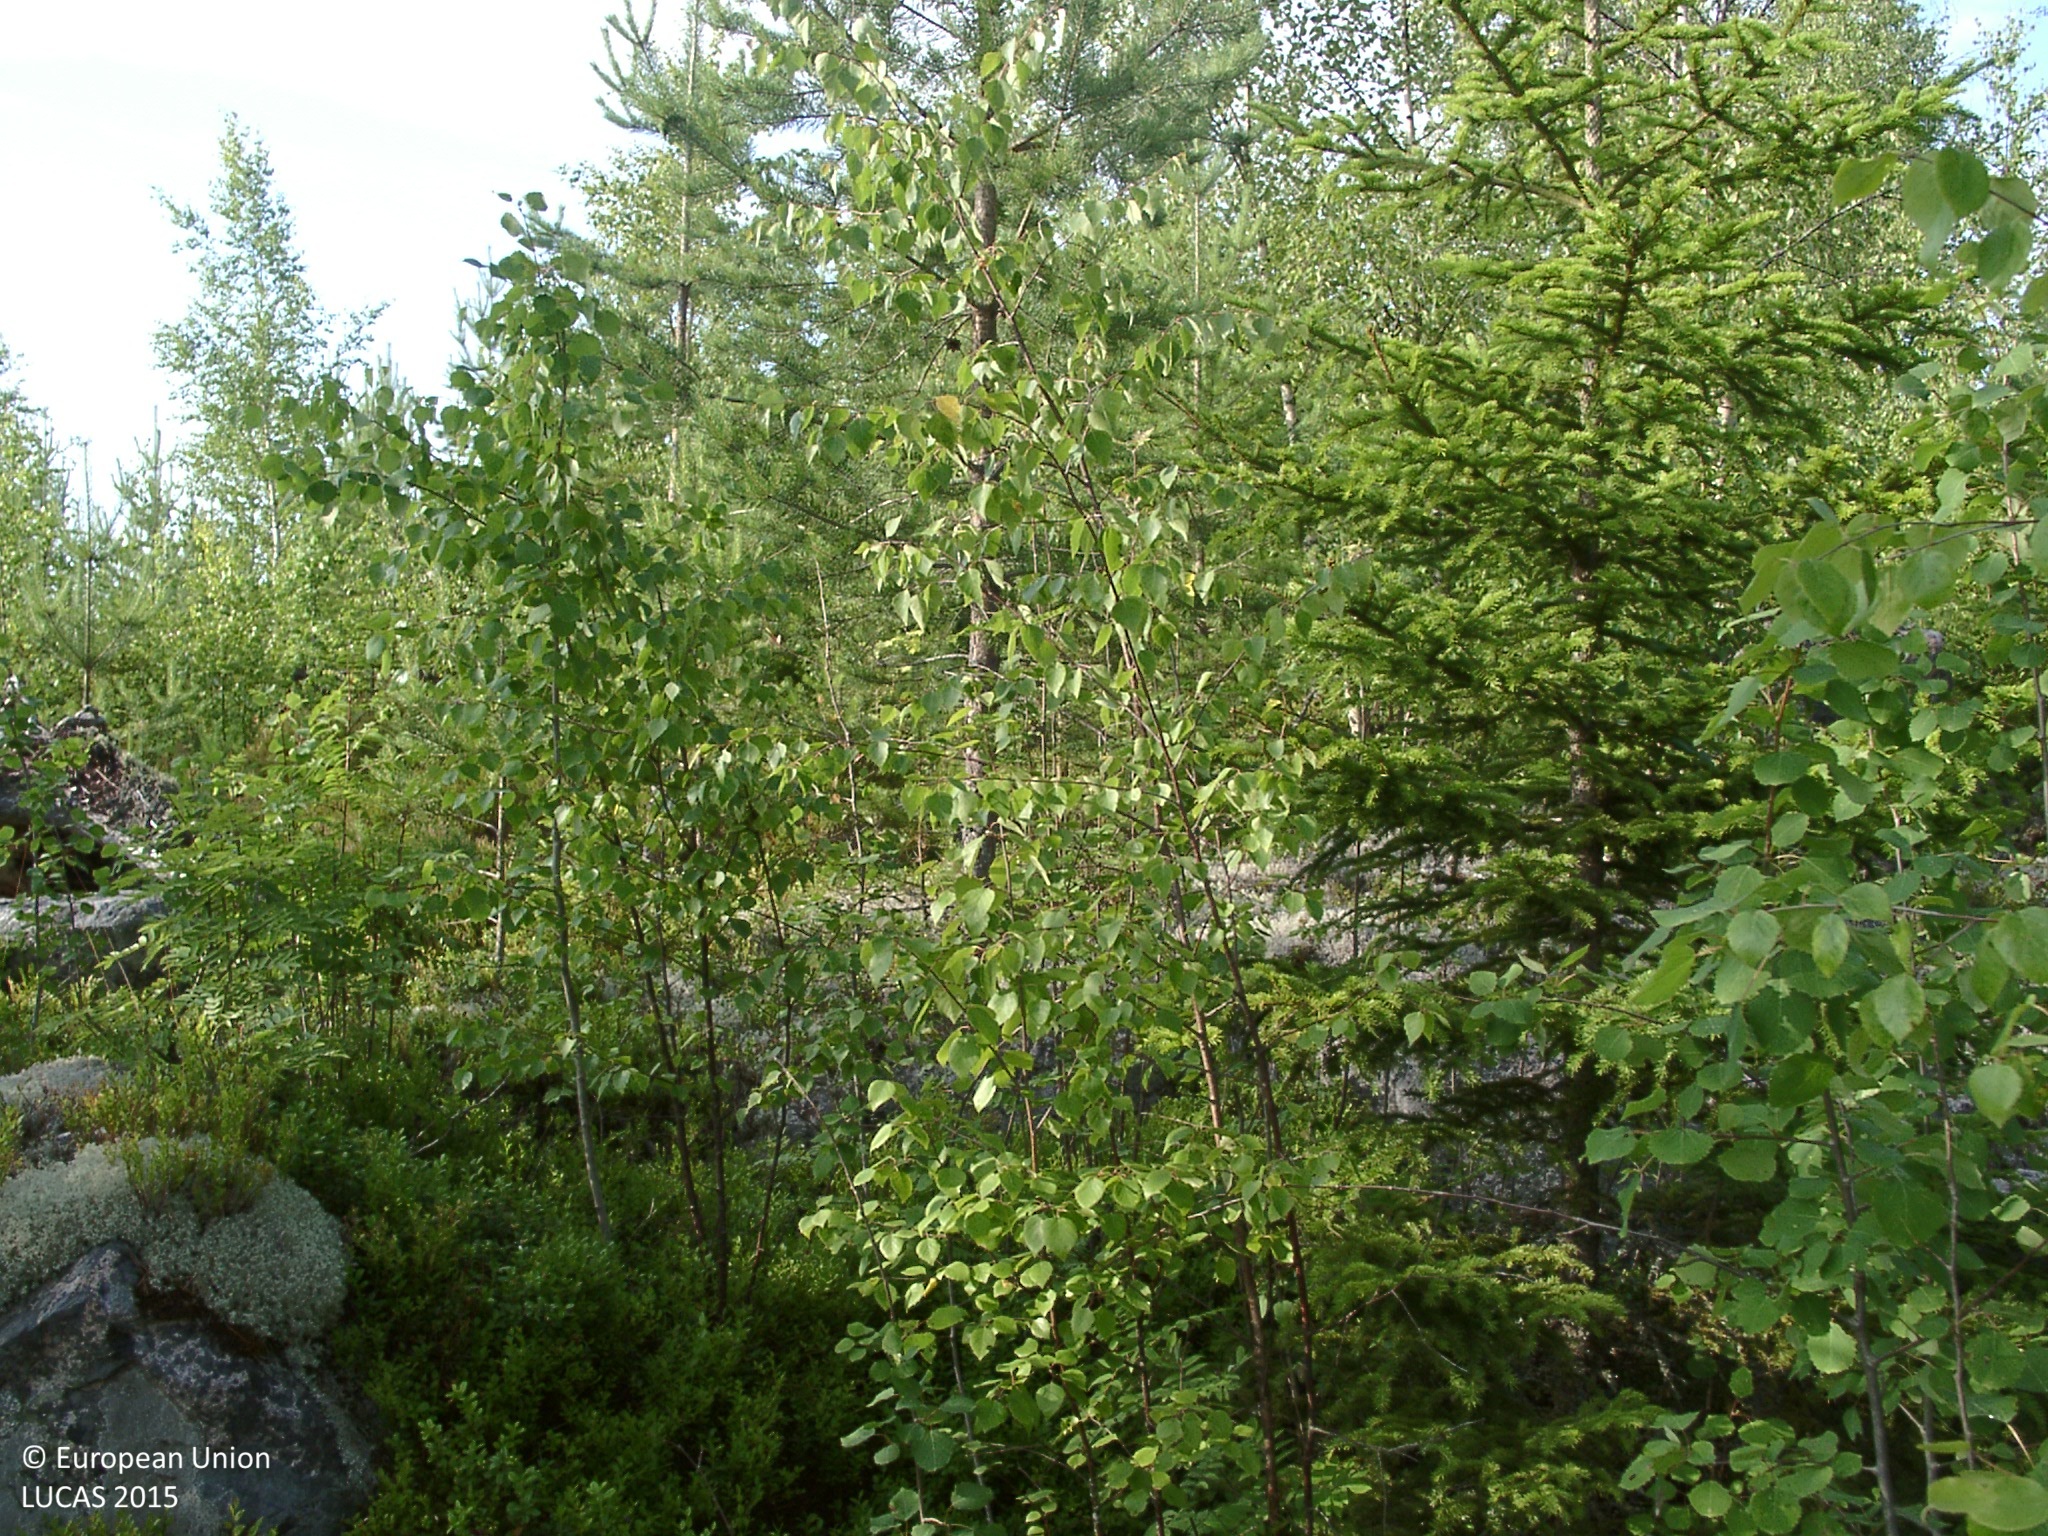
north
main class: Woodland
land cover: Pine dominated mixed woodland
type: boreal forest
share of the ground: 50 - 75 %
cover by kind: broadleaved forest trees 35 %, shrubs 25 %, coniferous forest trees 20 %, lichens and mosses 15 %, consolidated bare surface 5 %
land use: Forestry
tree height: < 5 m
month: July
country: FI
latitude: 61.7659
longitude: 24.7875
